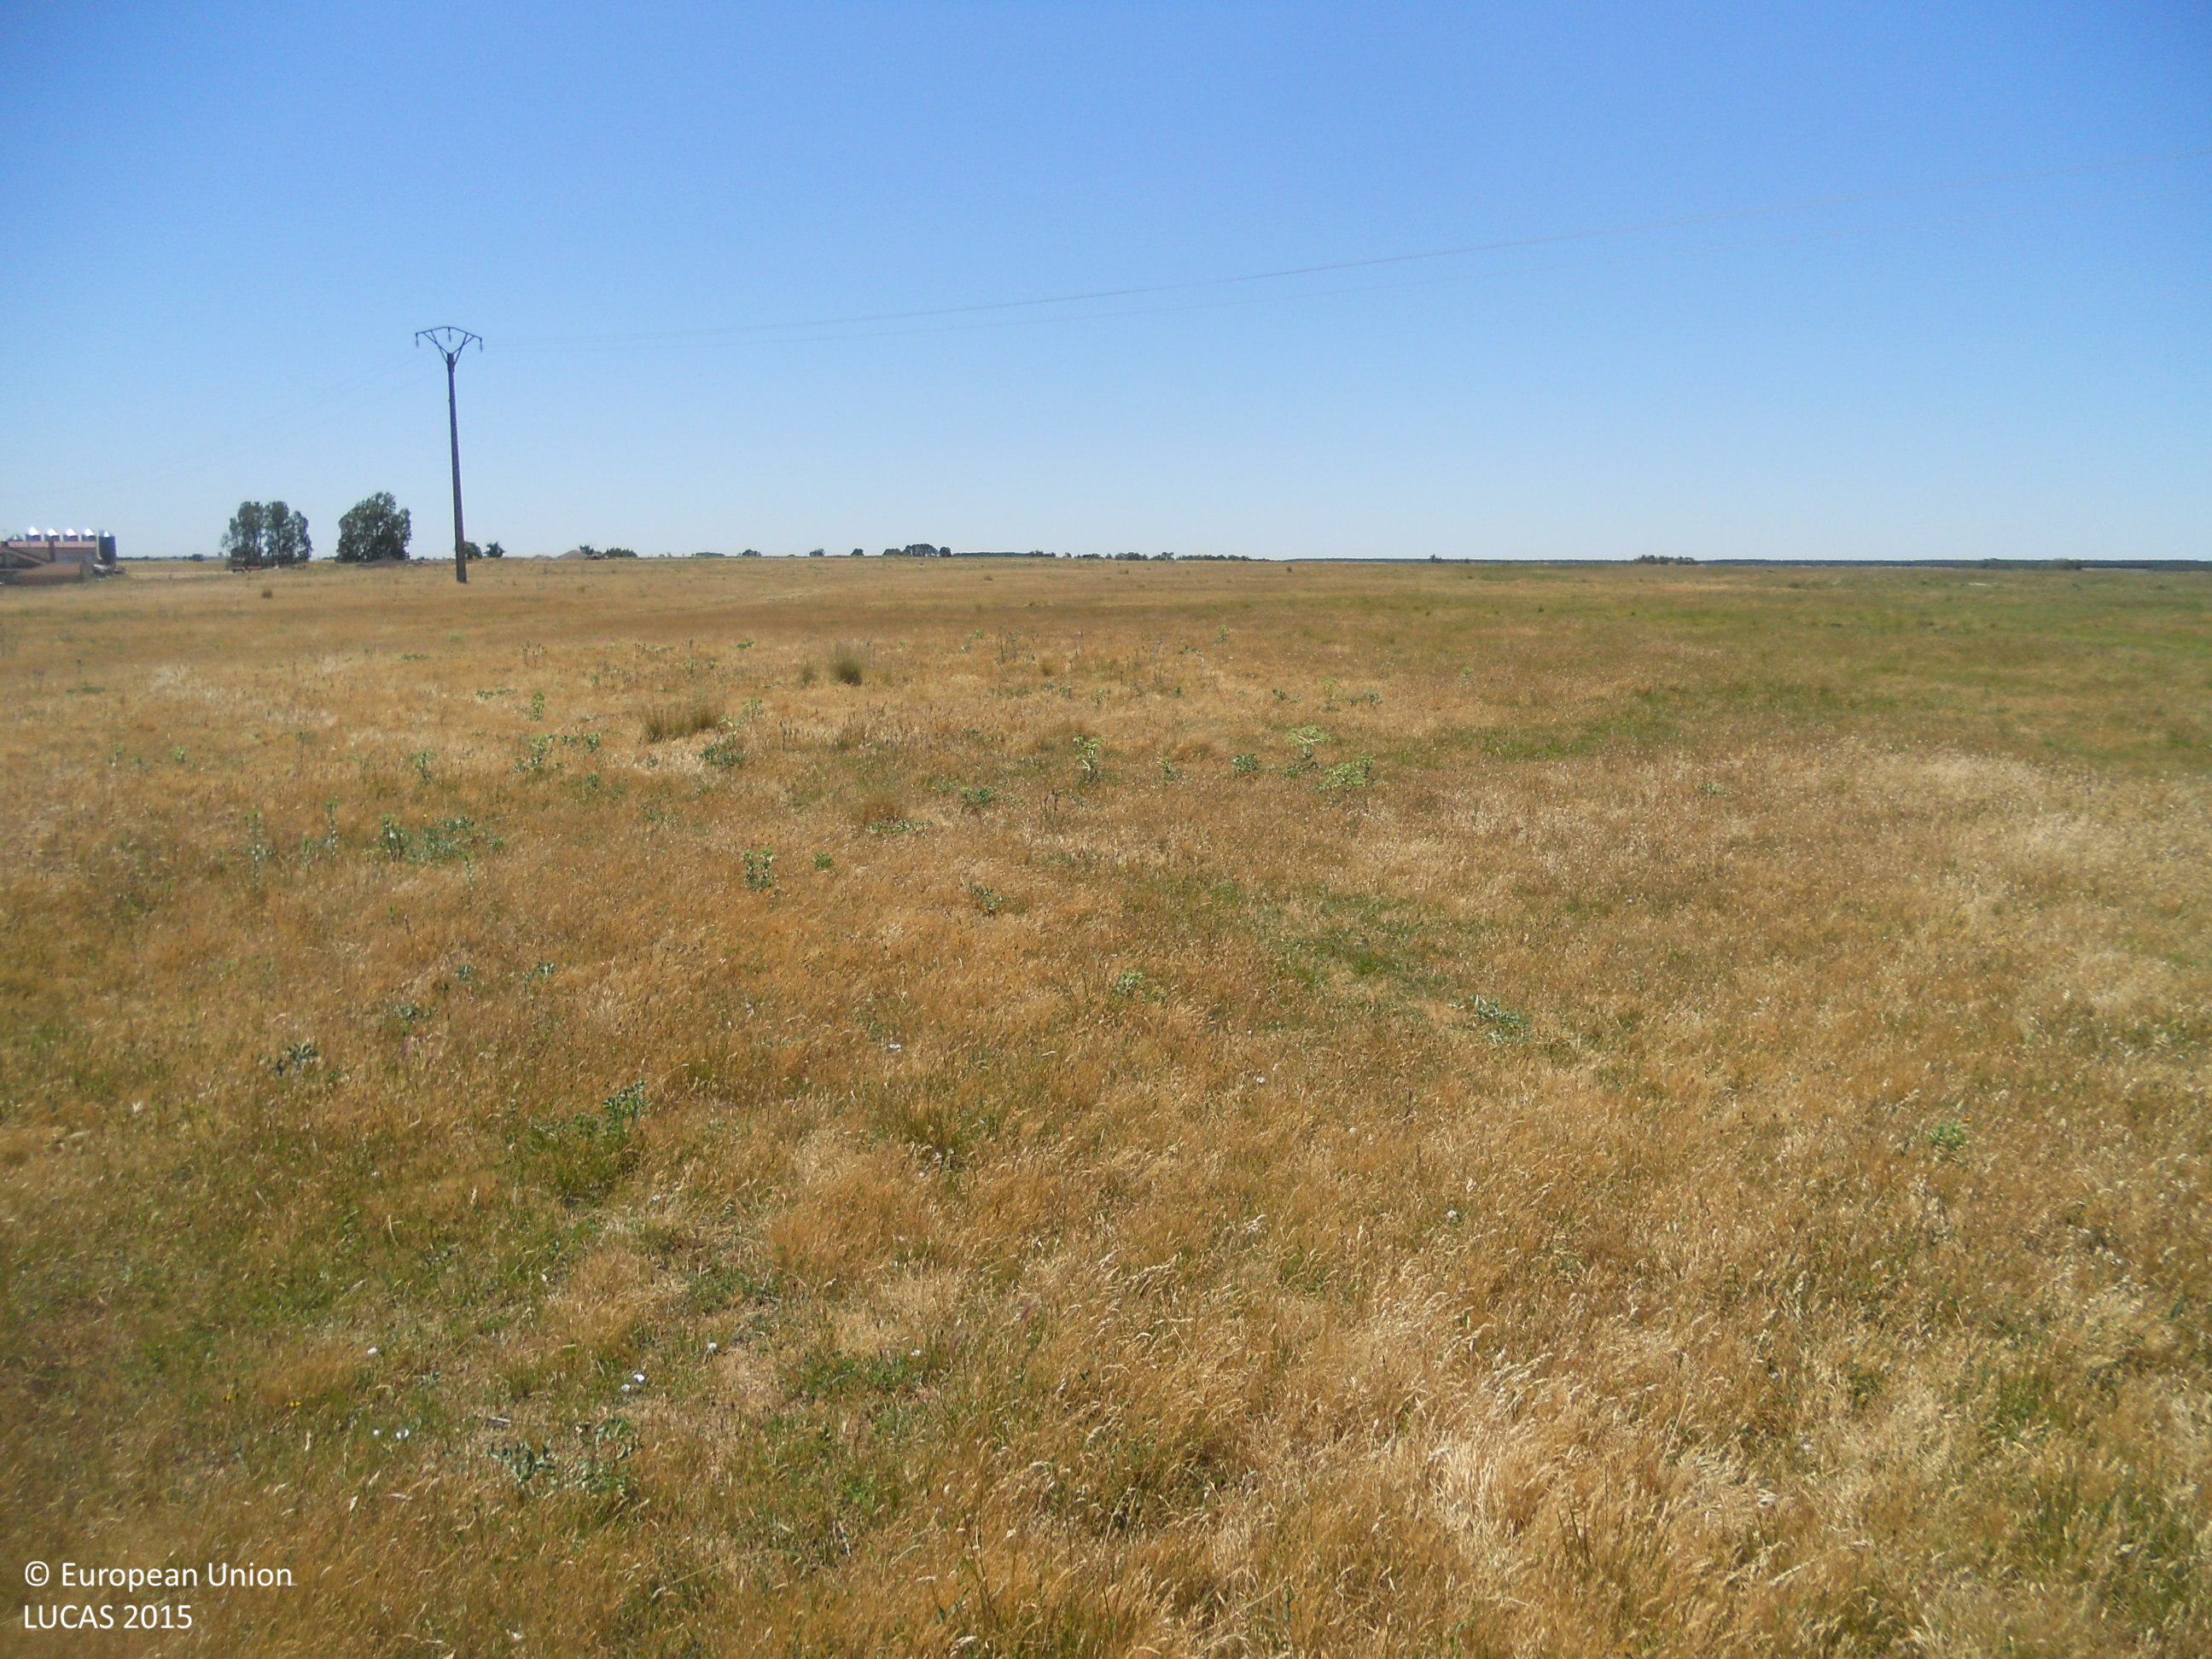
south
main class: Grassland
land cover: Grassland without tree/shrub cover
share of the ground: > 75 %
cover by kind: herbaceous plants 100 %
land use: Abandoned areas
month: June
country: ES
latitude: 42.5277
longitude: -4.8242
